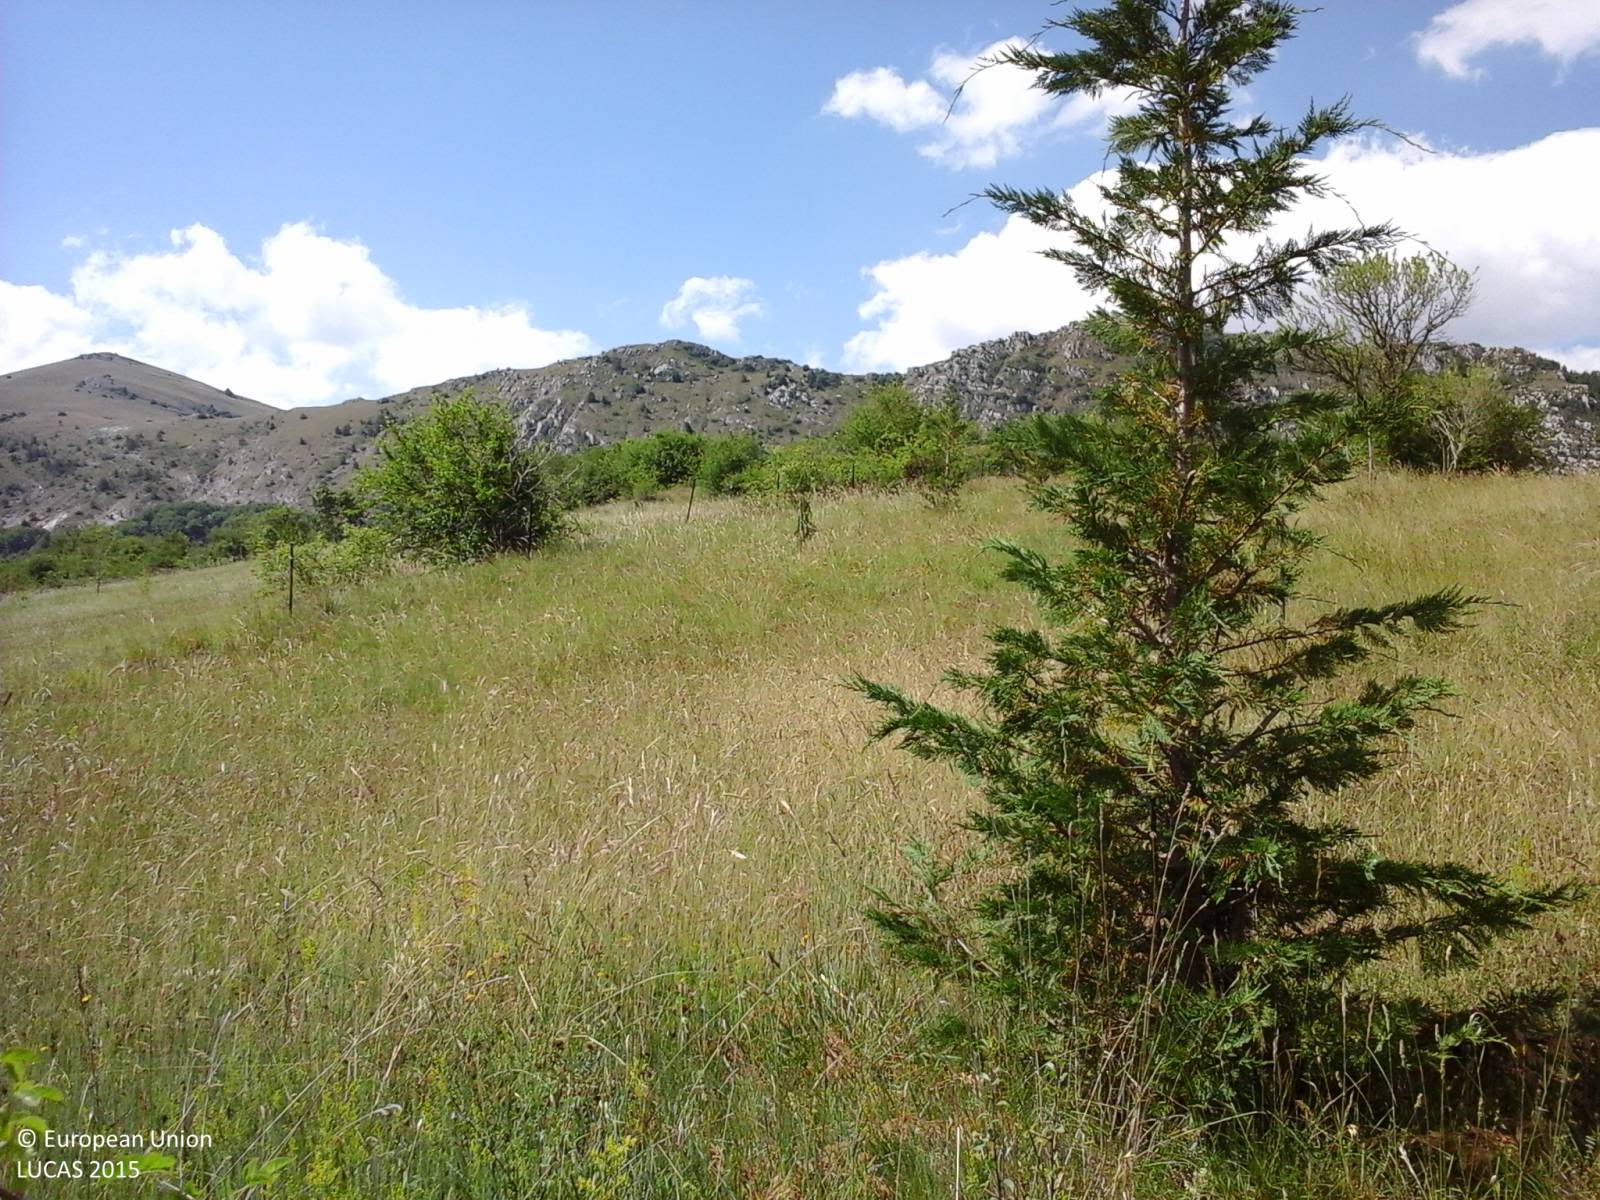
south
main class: Shrubland
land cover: Shrubland without tree cover
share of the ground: > 75 %
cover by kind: shrubs 100 %
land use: Semi-natural and natural areas not in use
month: June
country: IT
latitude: 42.0888
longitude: 13.4580
